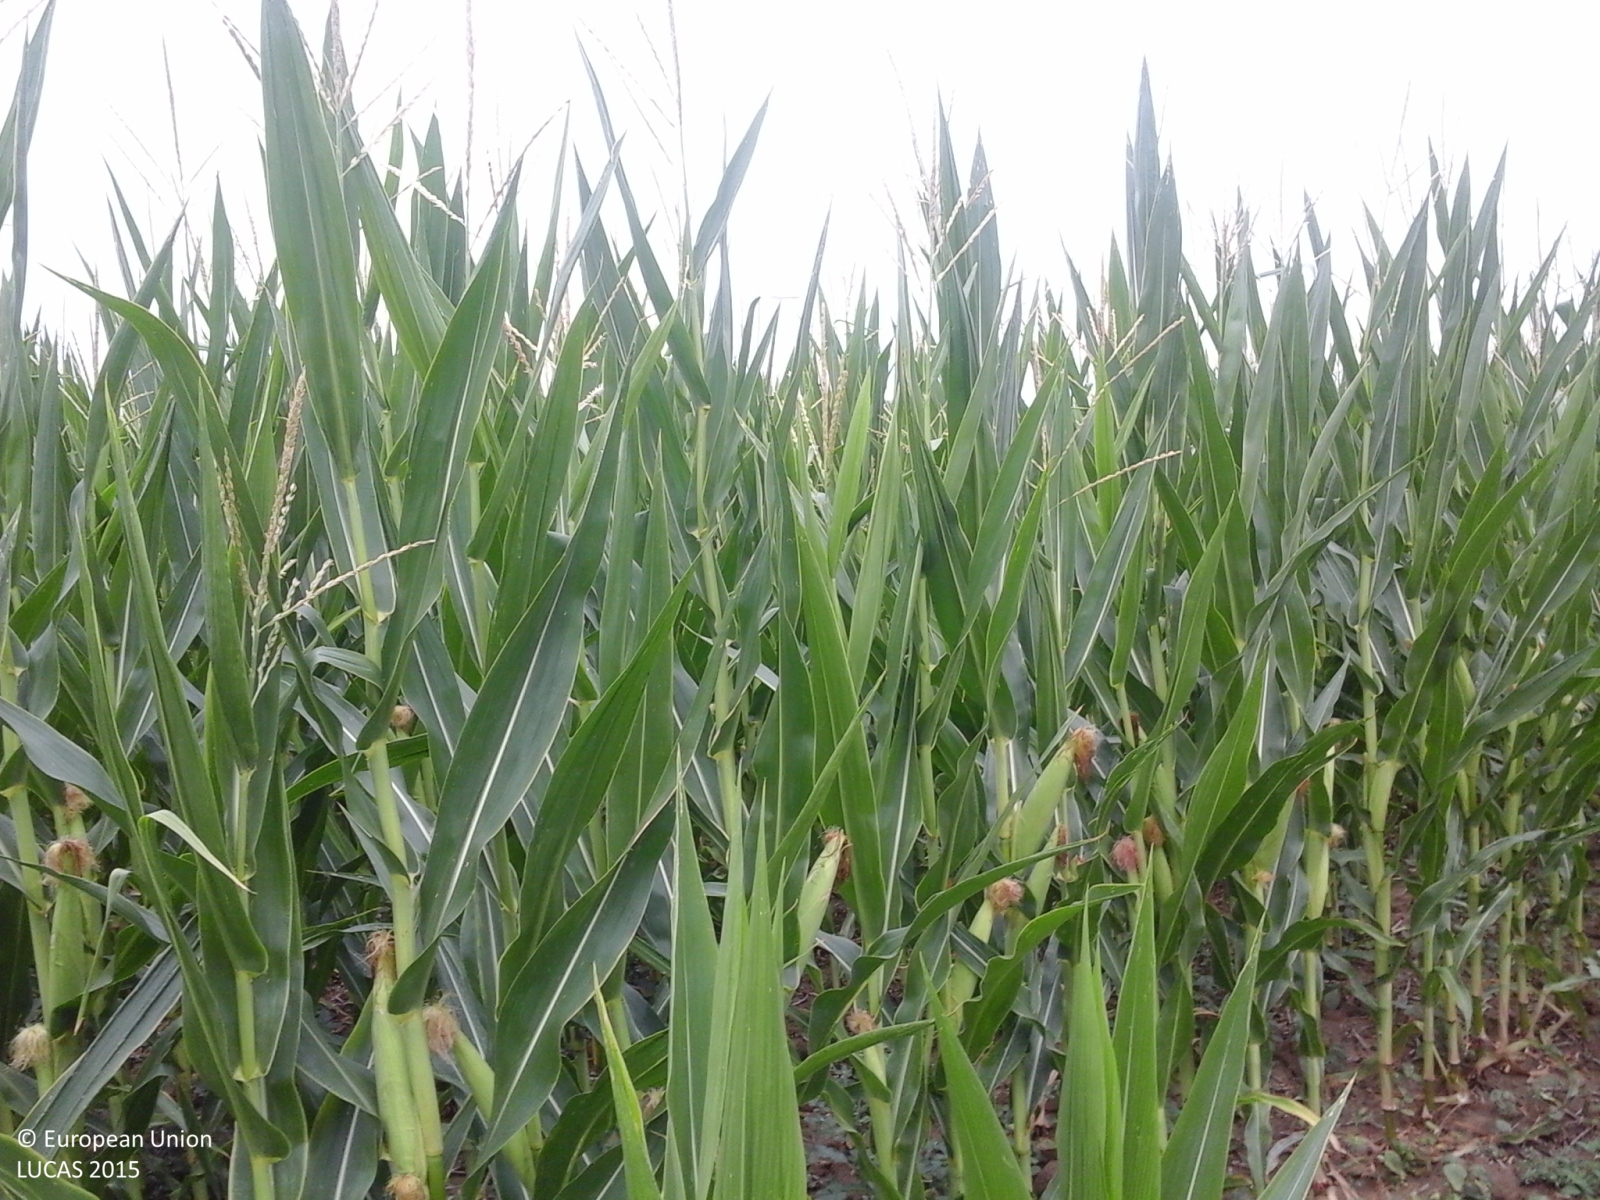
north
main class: Cropland
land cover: Maize
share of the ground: > 75 %
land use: Agriculture (excluding fallow land and kitchen gardens)
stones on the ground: < 10 %
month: August
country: IT
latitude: 44.3490
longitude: 12.0153
